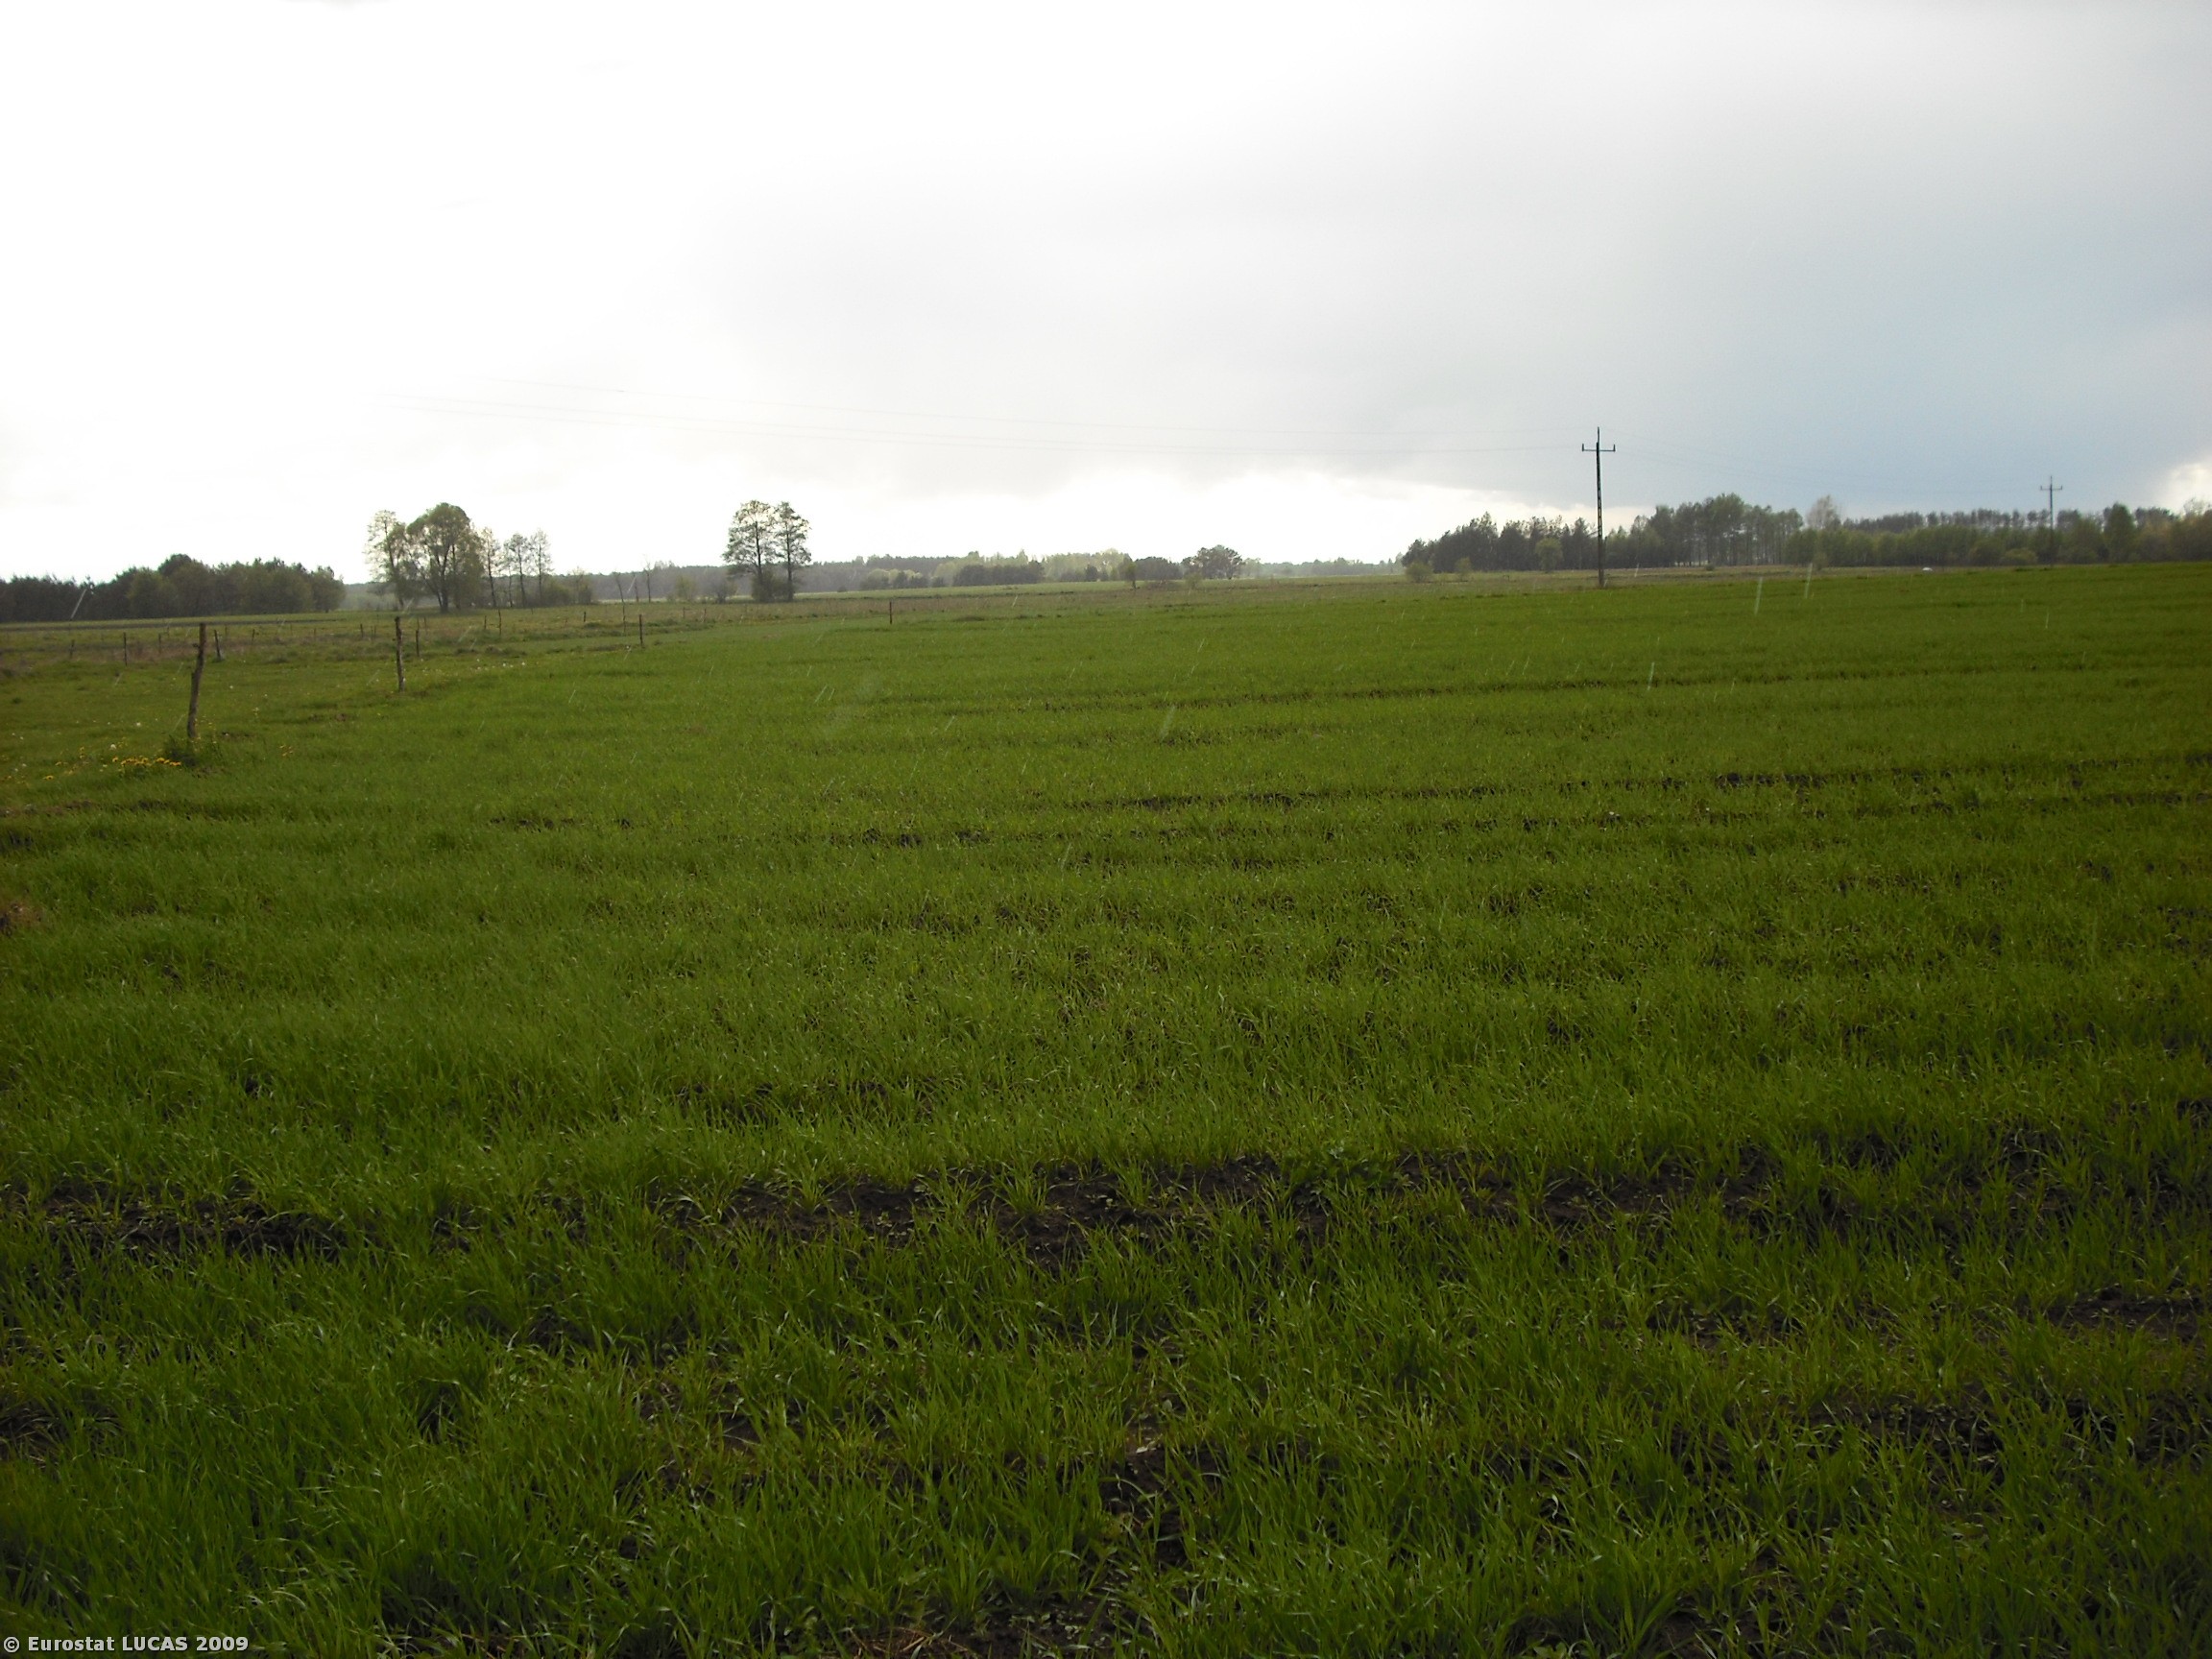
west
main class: Cropland
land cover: Oats
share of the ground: > 75 %
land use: Agriculture (excluding fallow land and kitchen gardens)
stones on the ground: < 10 %
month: May
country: PL
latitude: 52.9454
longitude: 23.5532
